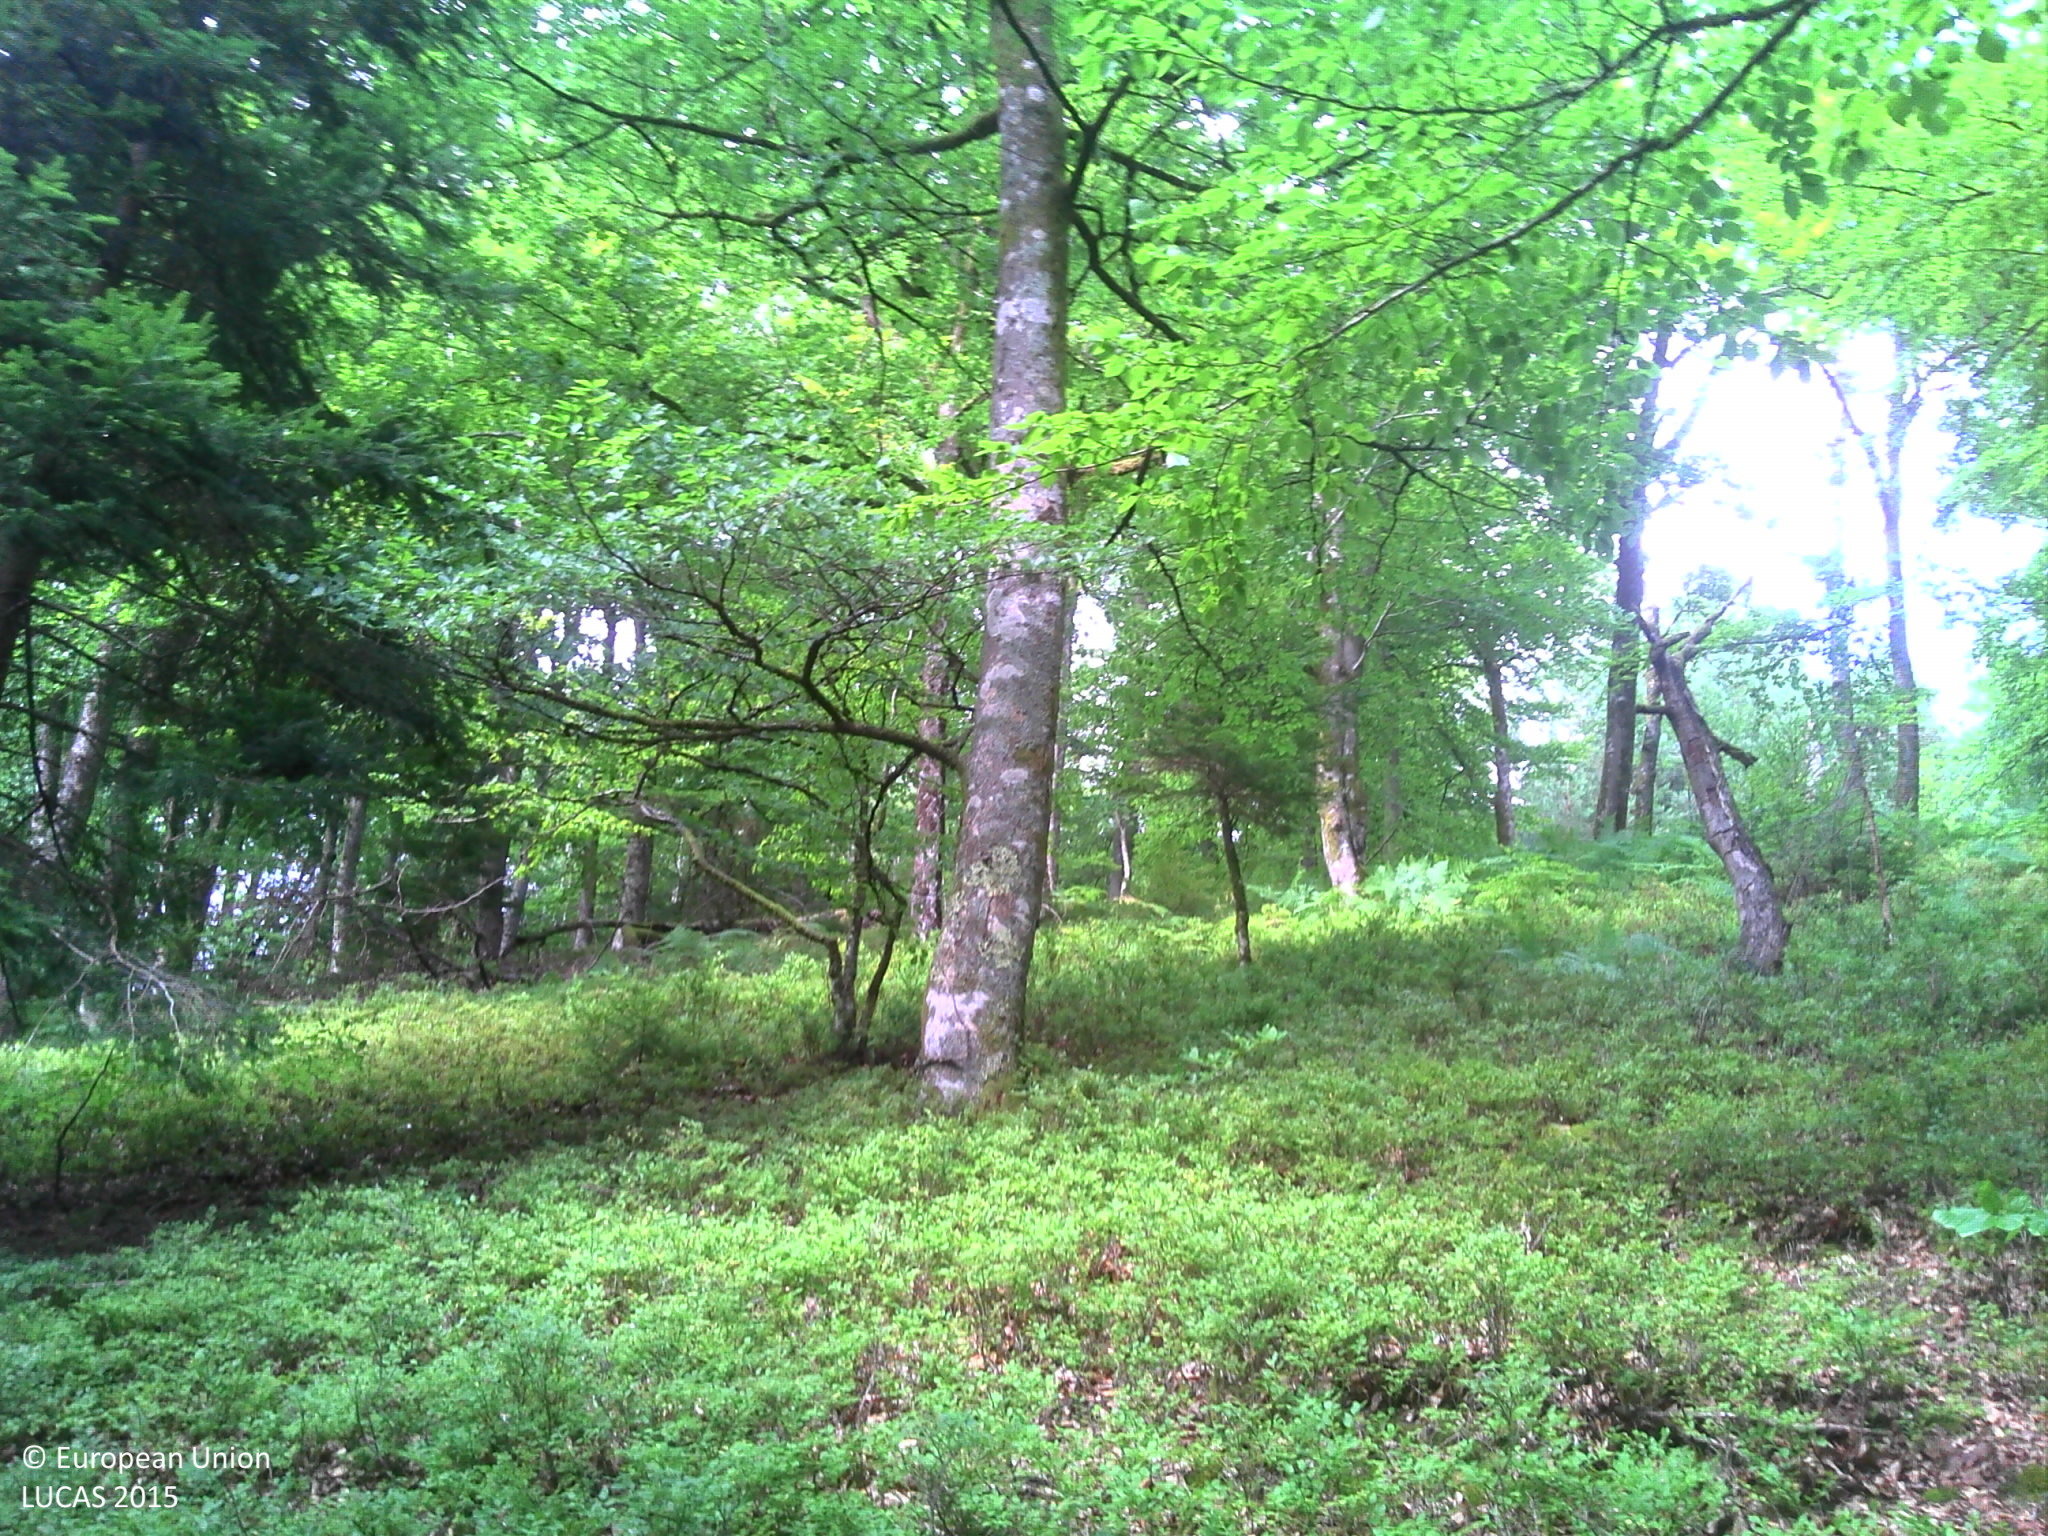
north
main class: Woodland
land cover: Other mixed woodland
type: hemiboreal forest and nemoral coniferous forest and mixed broadleaved-coniferous forest
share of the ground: > 75 %
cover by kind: broadleaved forest trees 60 %, coniferous forest trees 30 %, herbaceous plants 10 %
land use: Forestry
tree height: > 5 m
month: July
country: FR
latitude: 48.9481
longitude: 7.3652
